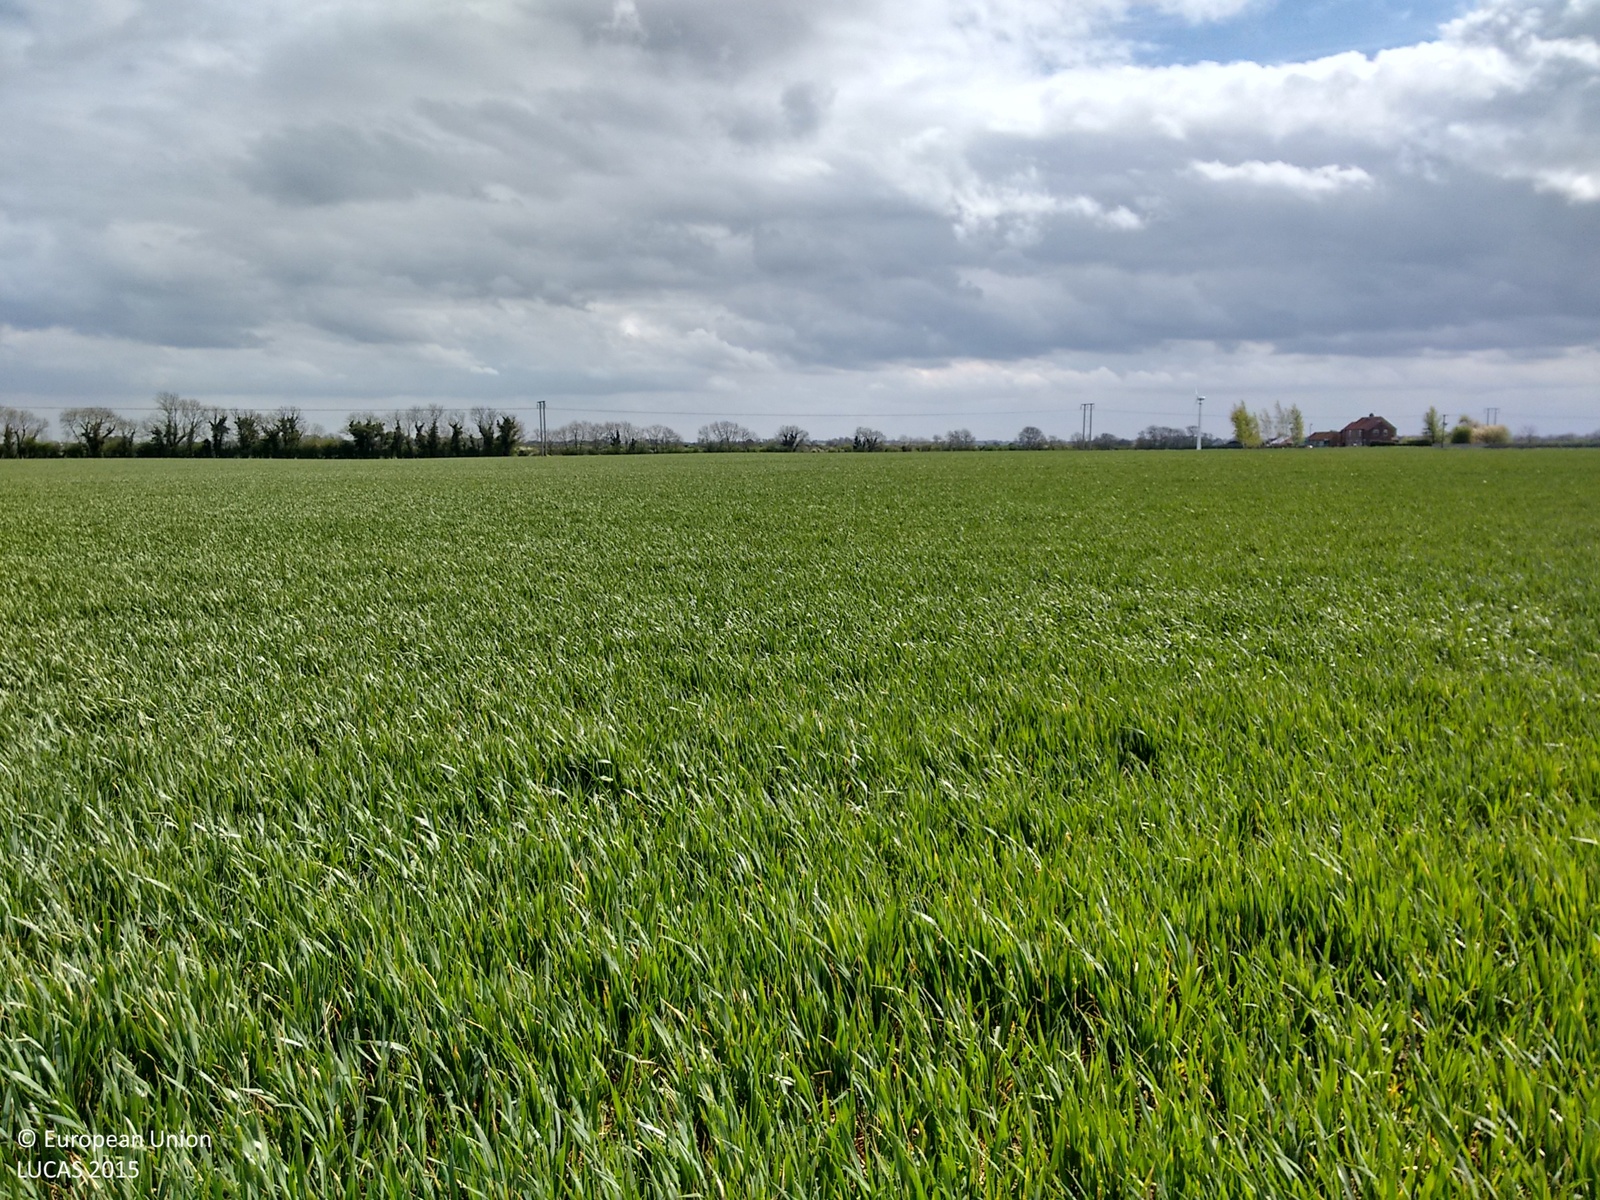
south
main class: Cropland
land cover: Common wheat
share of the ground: > 75 %
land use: Agriculture (excluding fallow land and kitchen gardens)
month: May
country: GB
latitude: 54.0254
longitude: -0.3694
